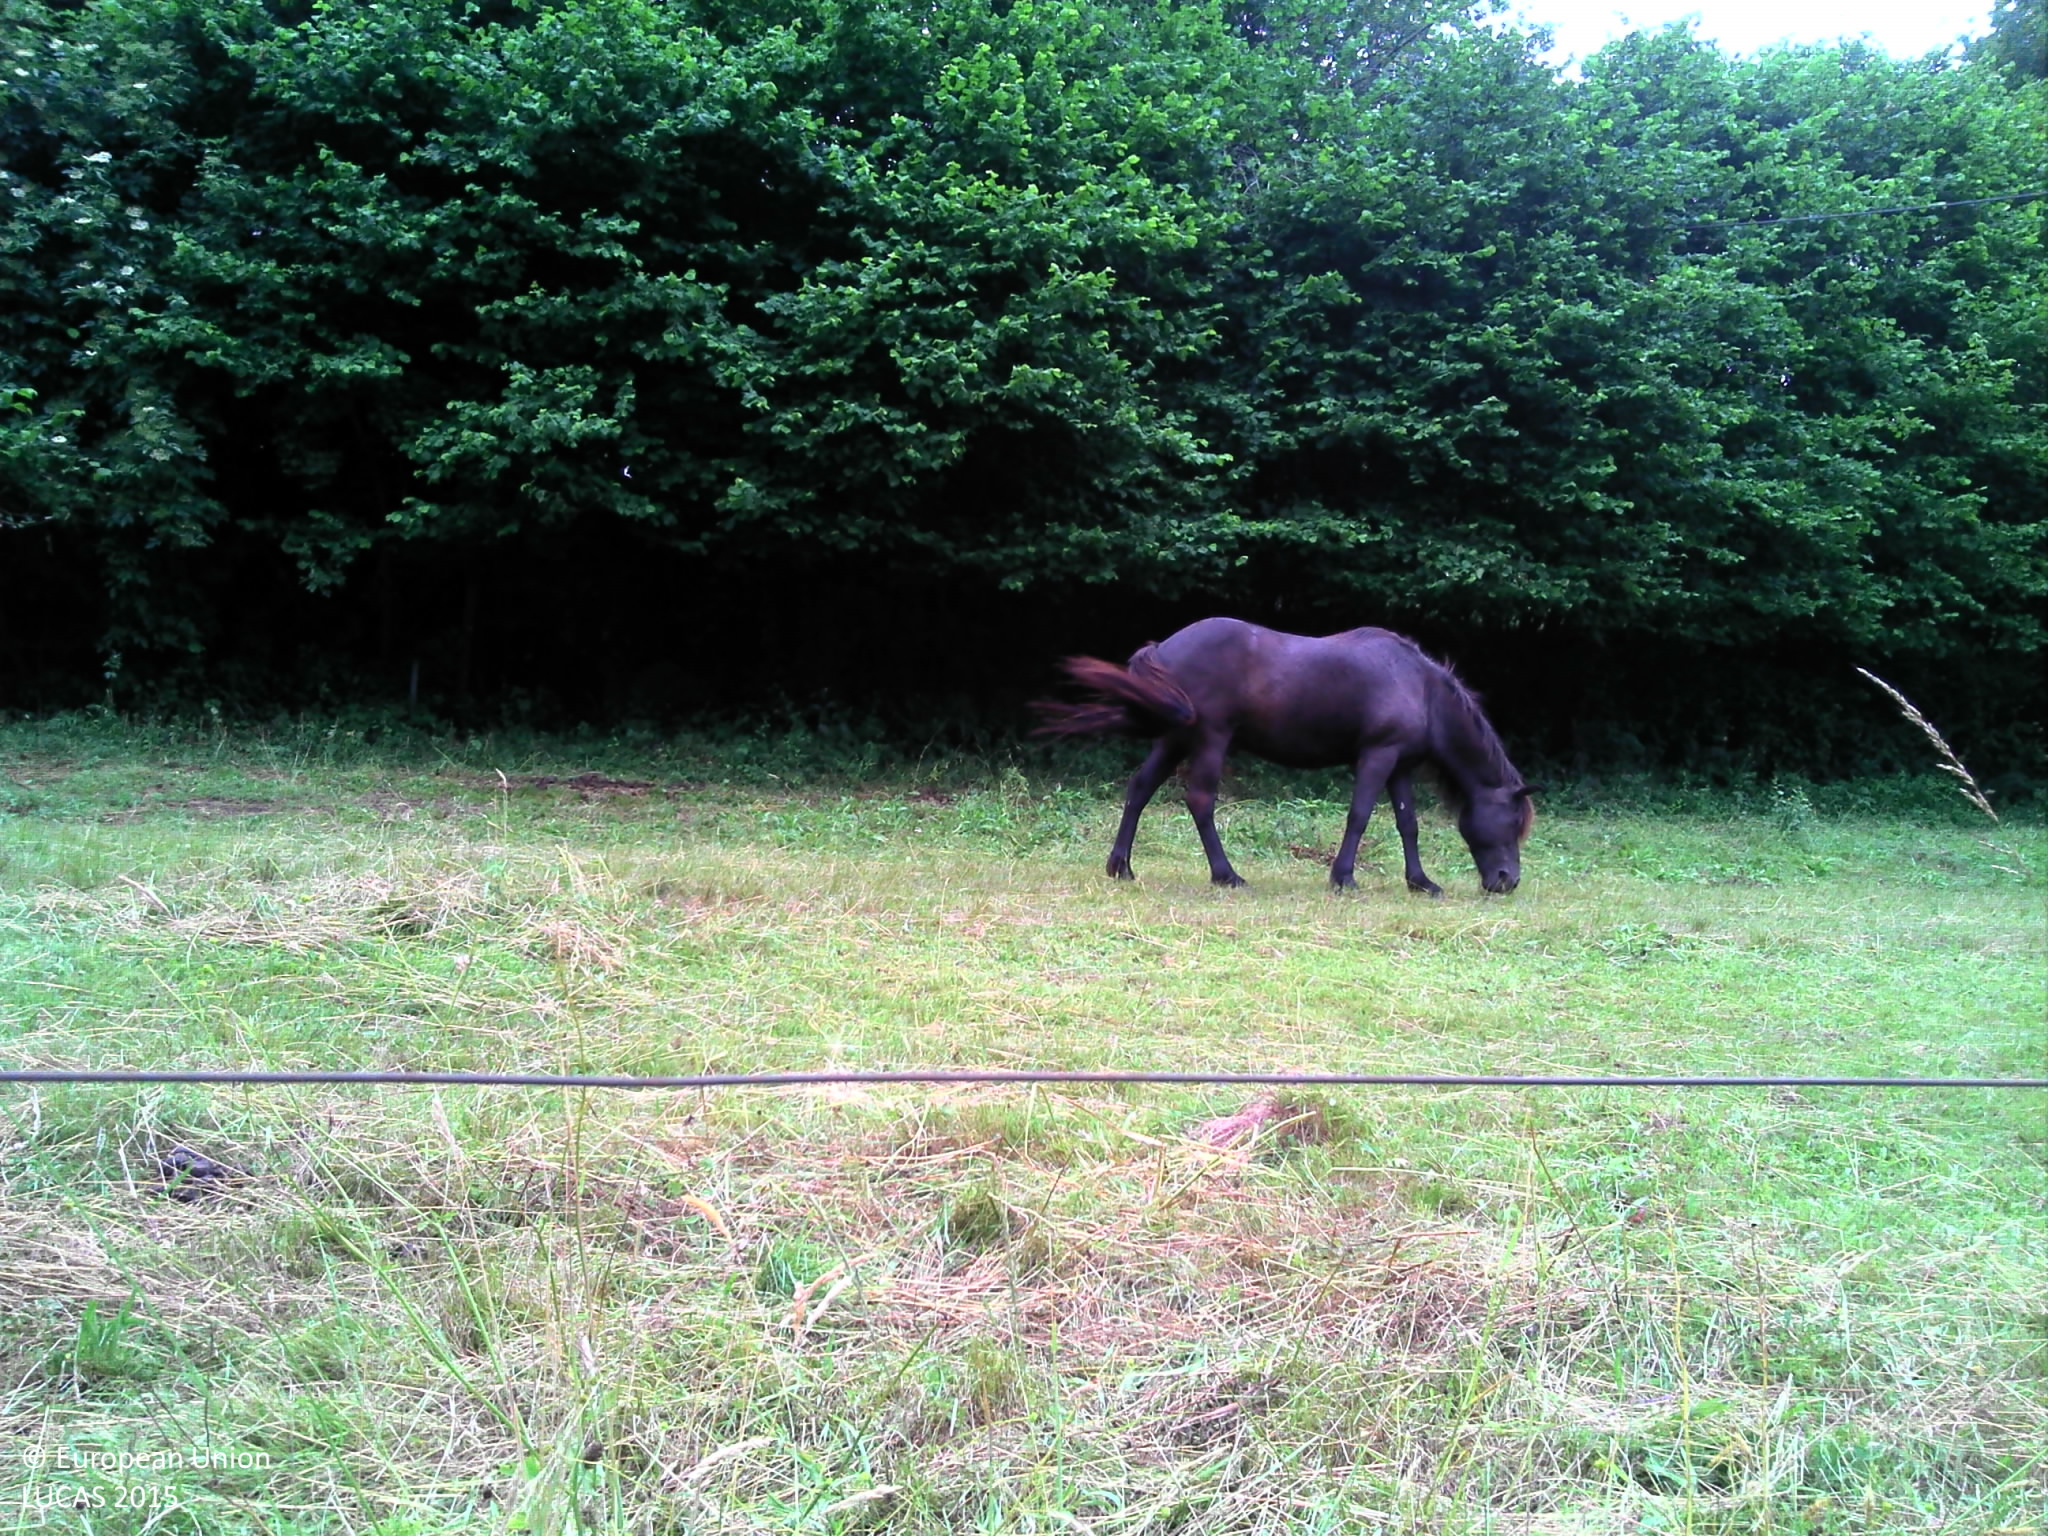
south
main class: Grassland
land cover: Grassland without tree/shrub cover
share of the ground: > 75 %
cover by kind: herbaceous plants 100 %
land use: Agriculture (excluding fallow land and kitchen gardens)
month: June
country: FR
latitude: 49.0279
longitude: 7.7166
